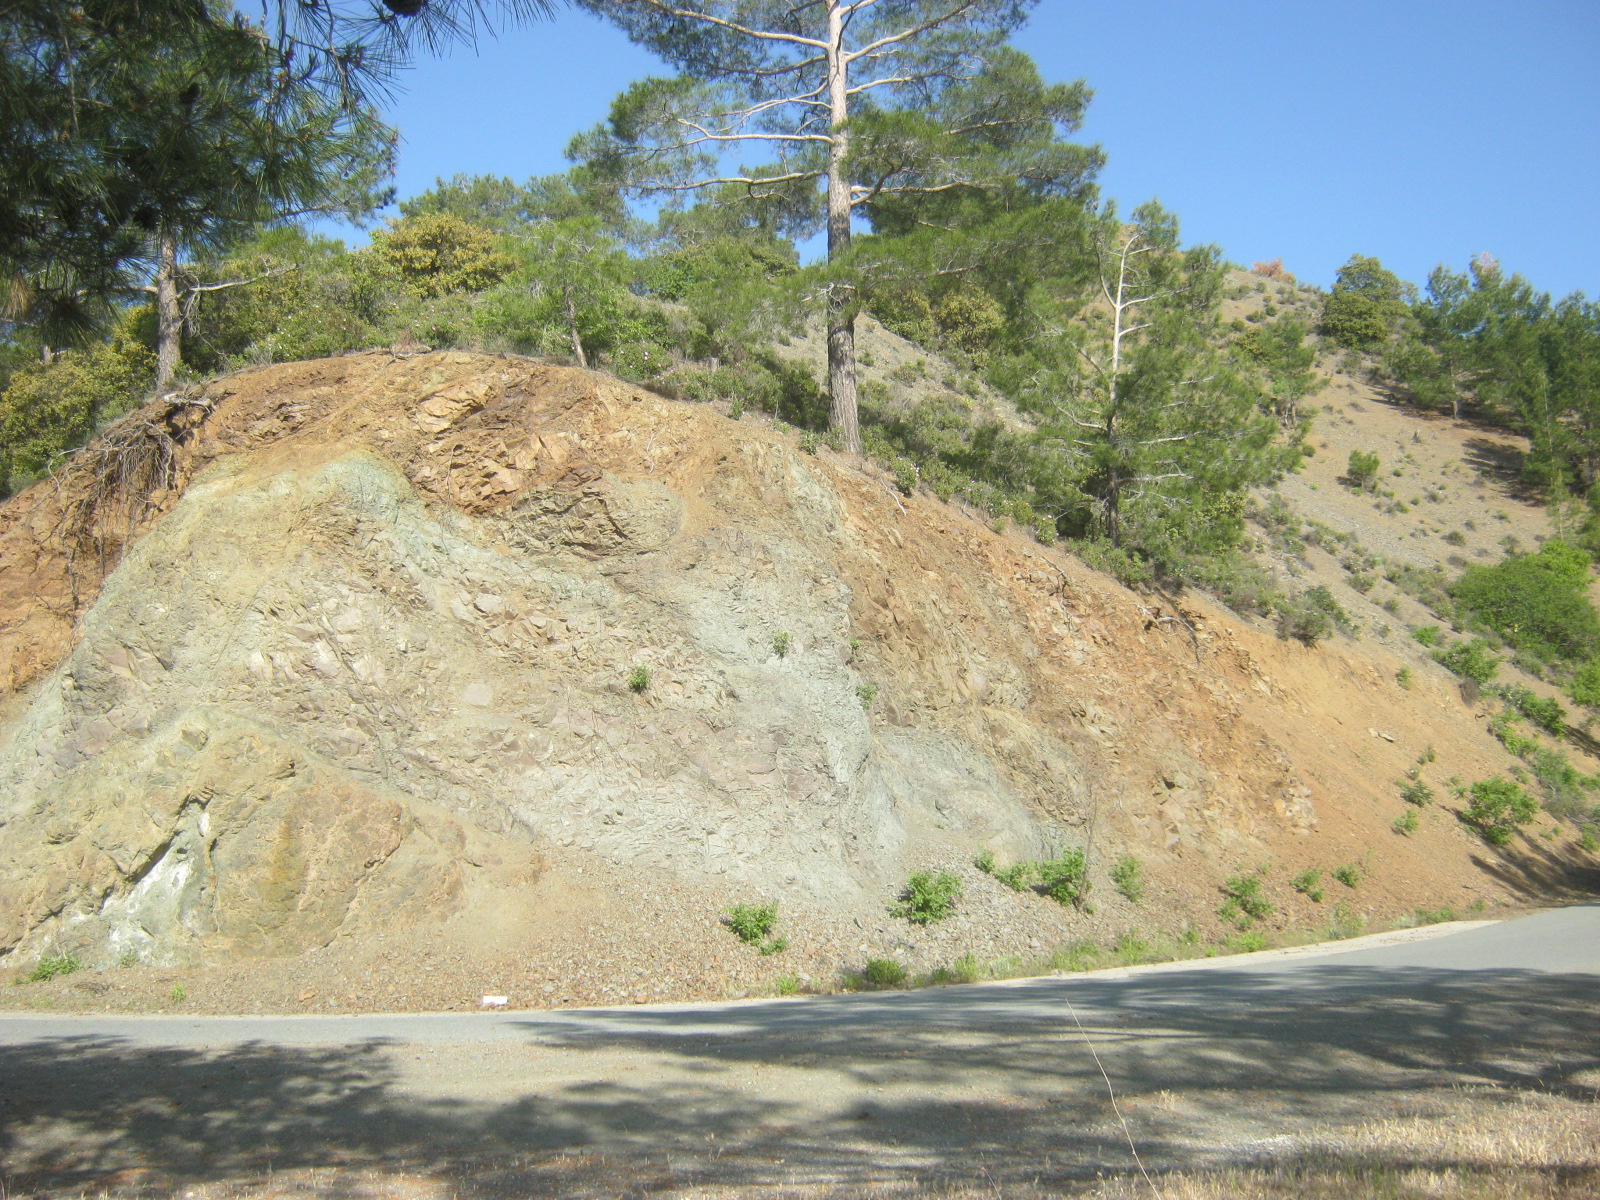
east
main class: Woodland
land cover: Pine dominated coniferous woodland
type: coniferous forest of the mediterranean region
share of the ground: > 75 %
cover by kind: coniferous forest trees 80 %, broadleaved forest trees 10 %, shrubs 10 %
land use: Semi-natural and natural areas not in use
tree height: > 5 m
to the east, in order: Pine dominated coniferous woodland; Paved roads, cycling and walking lanes; Pine dominated coniferous woodland
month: May
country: CY
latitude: 34.9745
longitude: 32.8061
